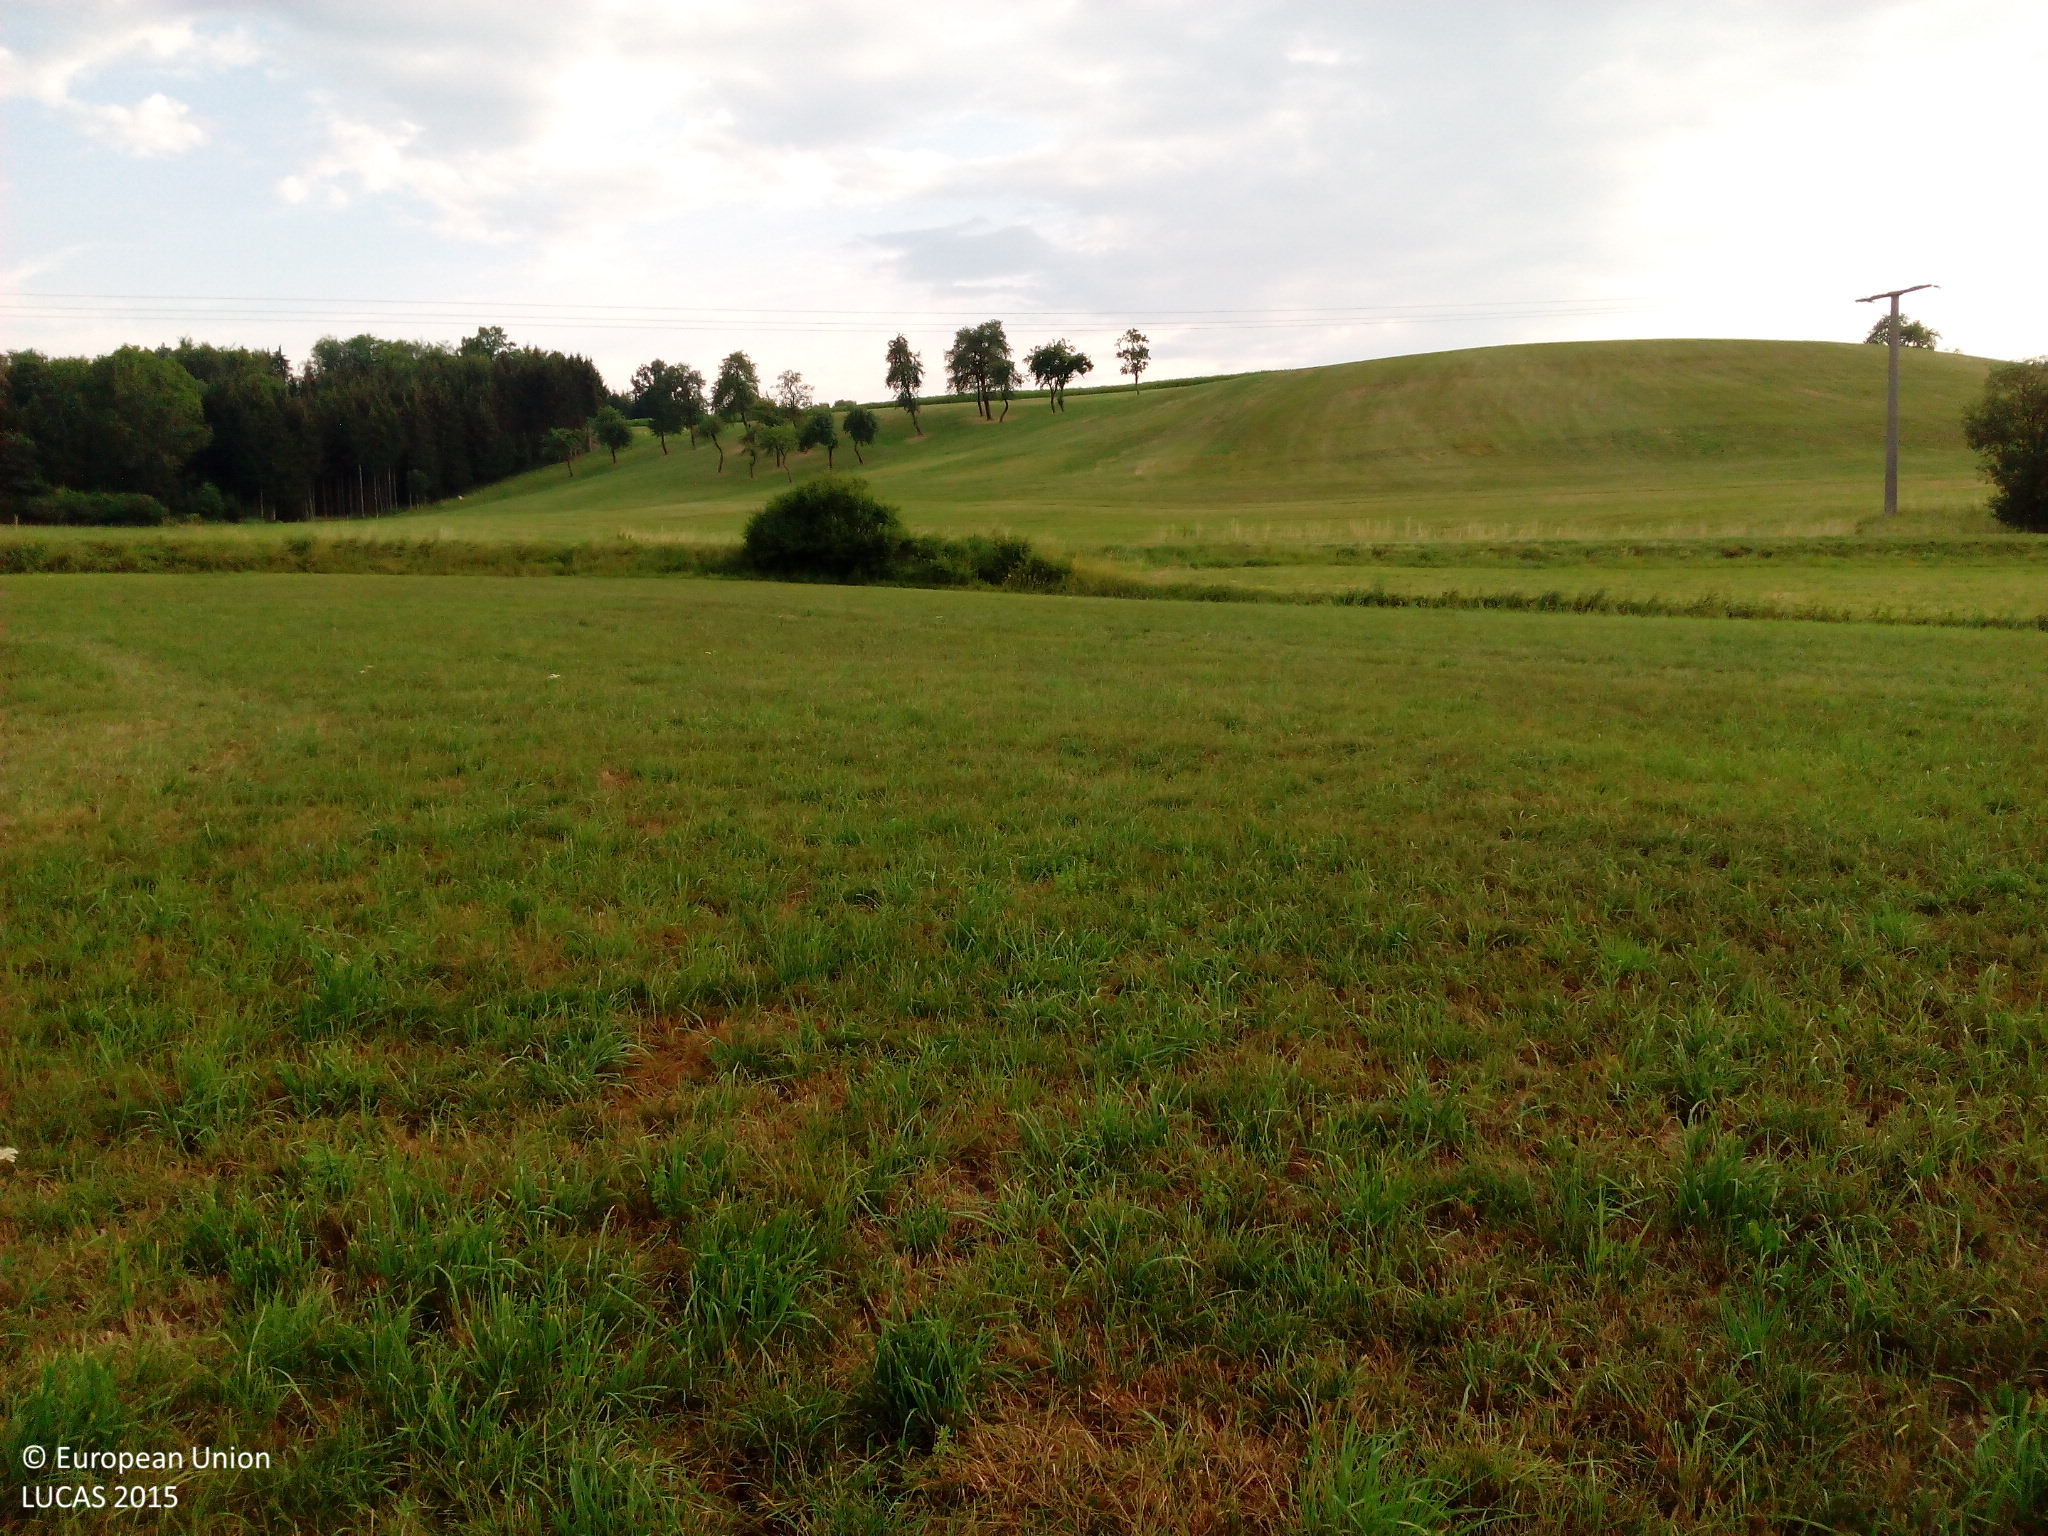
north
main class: Grassland
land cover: Grassland without tree/shrub cover
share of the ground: > 75 %
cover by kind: herbaceous plants 95 %, unconsolidated bare surface 5 %
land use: Agriculture (excluding fallow land and kitchen gardens)
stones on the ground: < 10 %
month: July
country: DE
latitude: 49.1051
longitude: 9.9589
